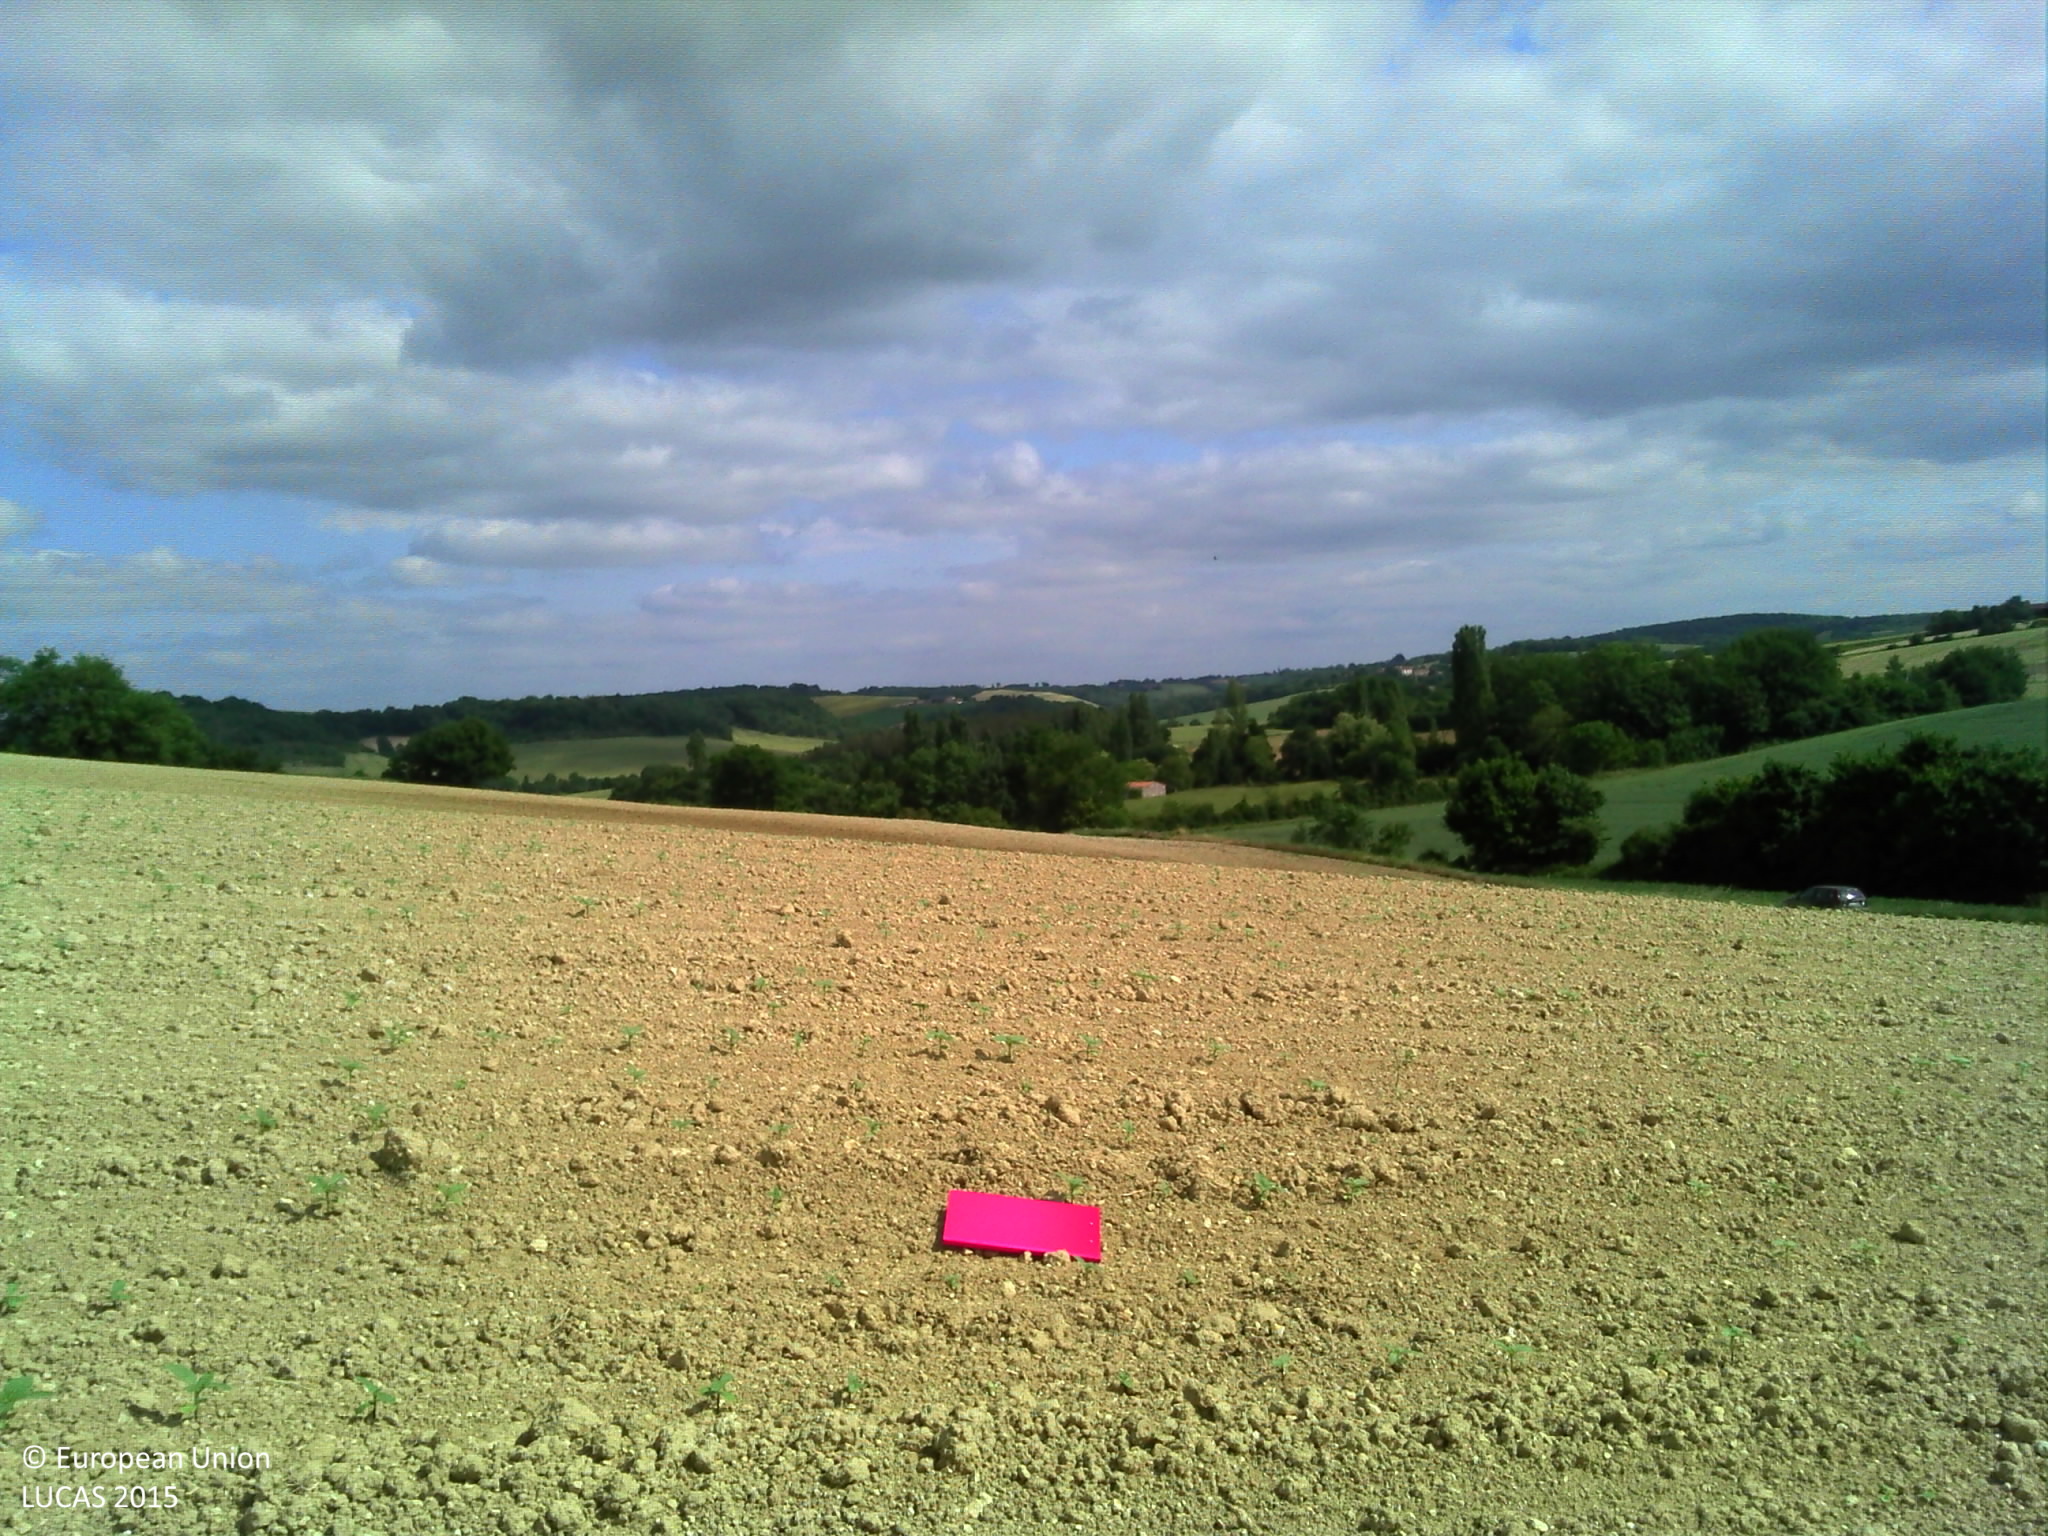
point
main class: Cropland
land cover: Sunflower
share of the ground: < 10 %
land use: Agriculture (excluding fallow land and kitchen gardens)
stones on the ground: < 10 %
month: June
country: FR
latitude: 43.5692
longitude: 0.7003
